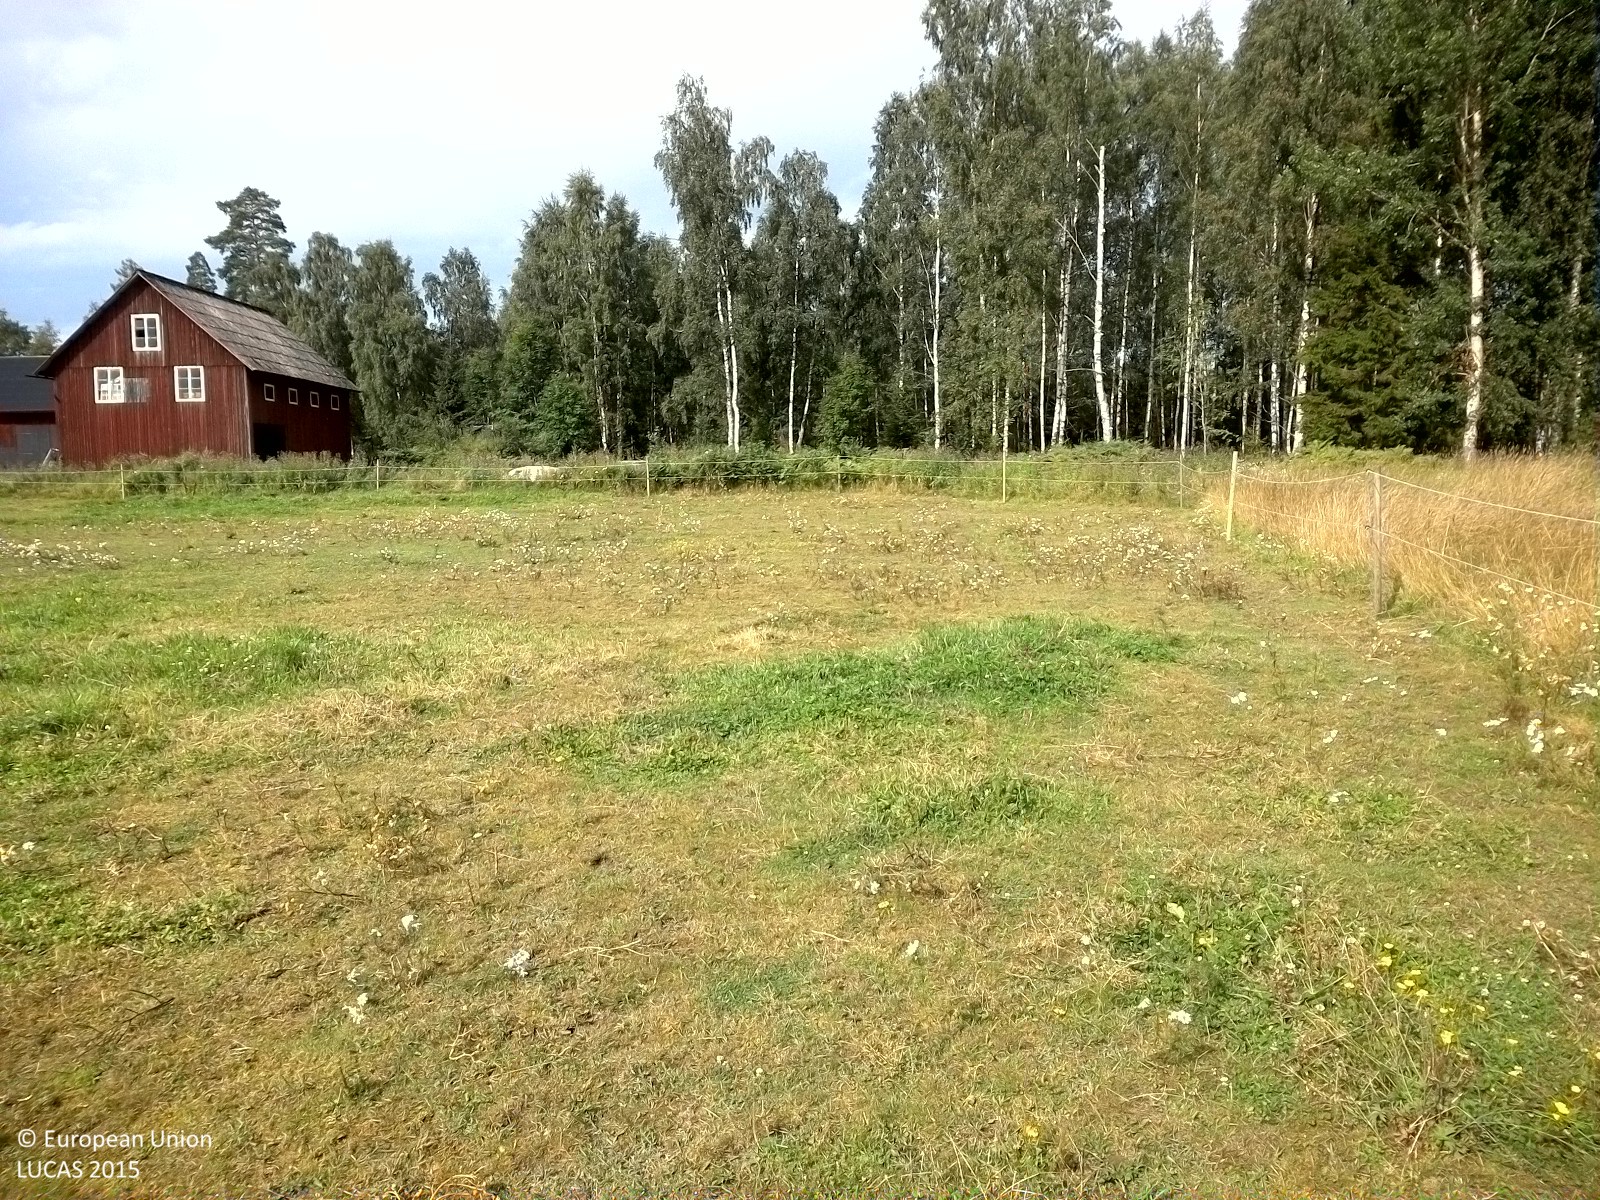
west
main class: Grassland
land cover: Grassland without tree/shrub cover
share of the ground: > 75 %
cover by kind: herbaceous plants 100 %
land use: Agriculture (excluding fallow land and kitchen gardens)
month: August
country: SE
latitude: 59.0975
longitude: 15.0720
